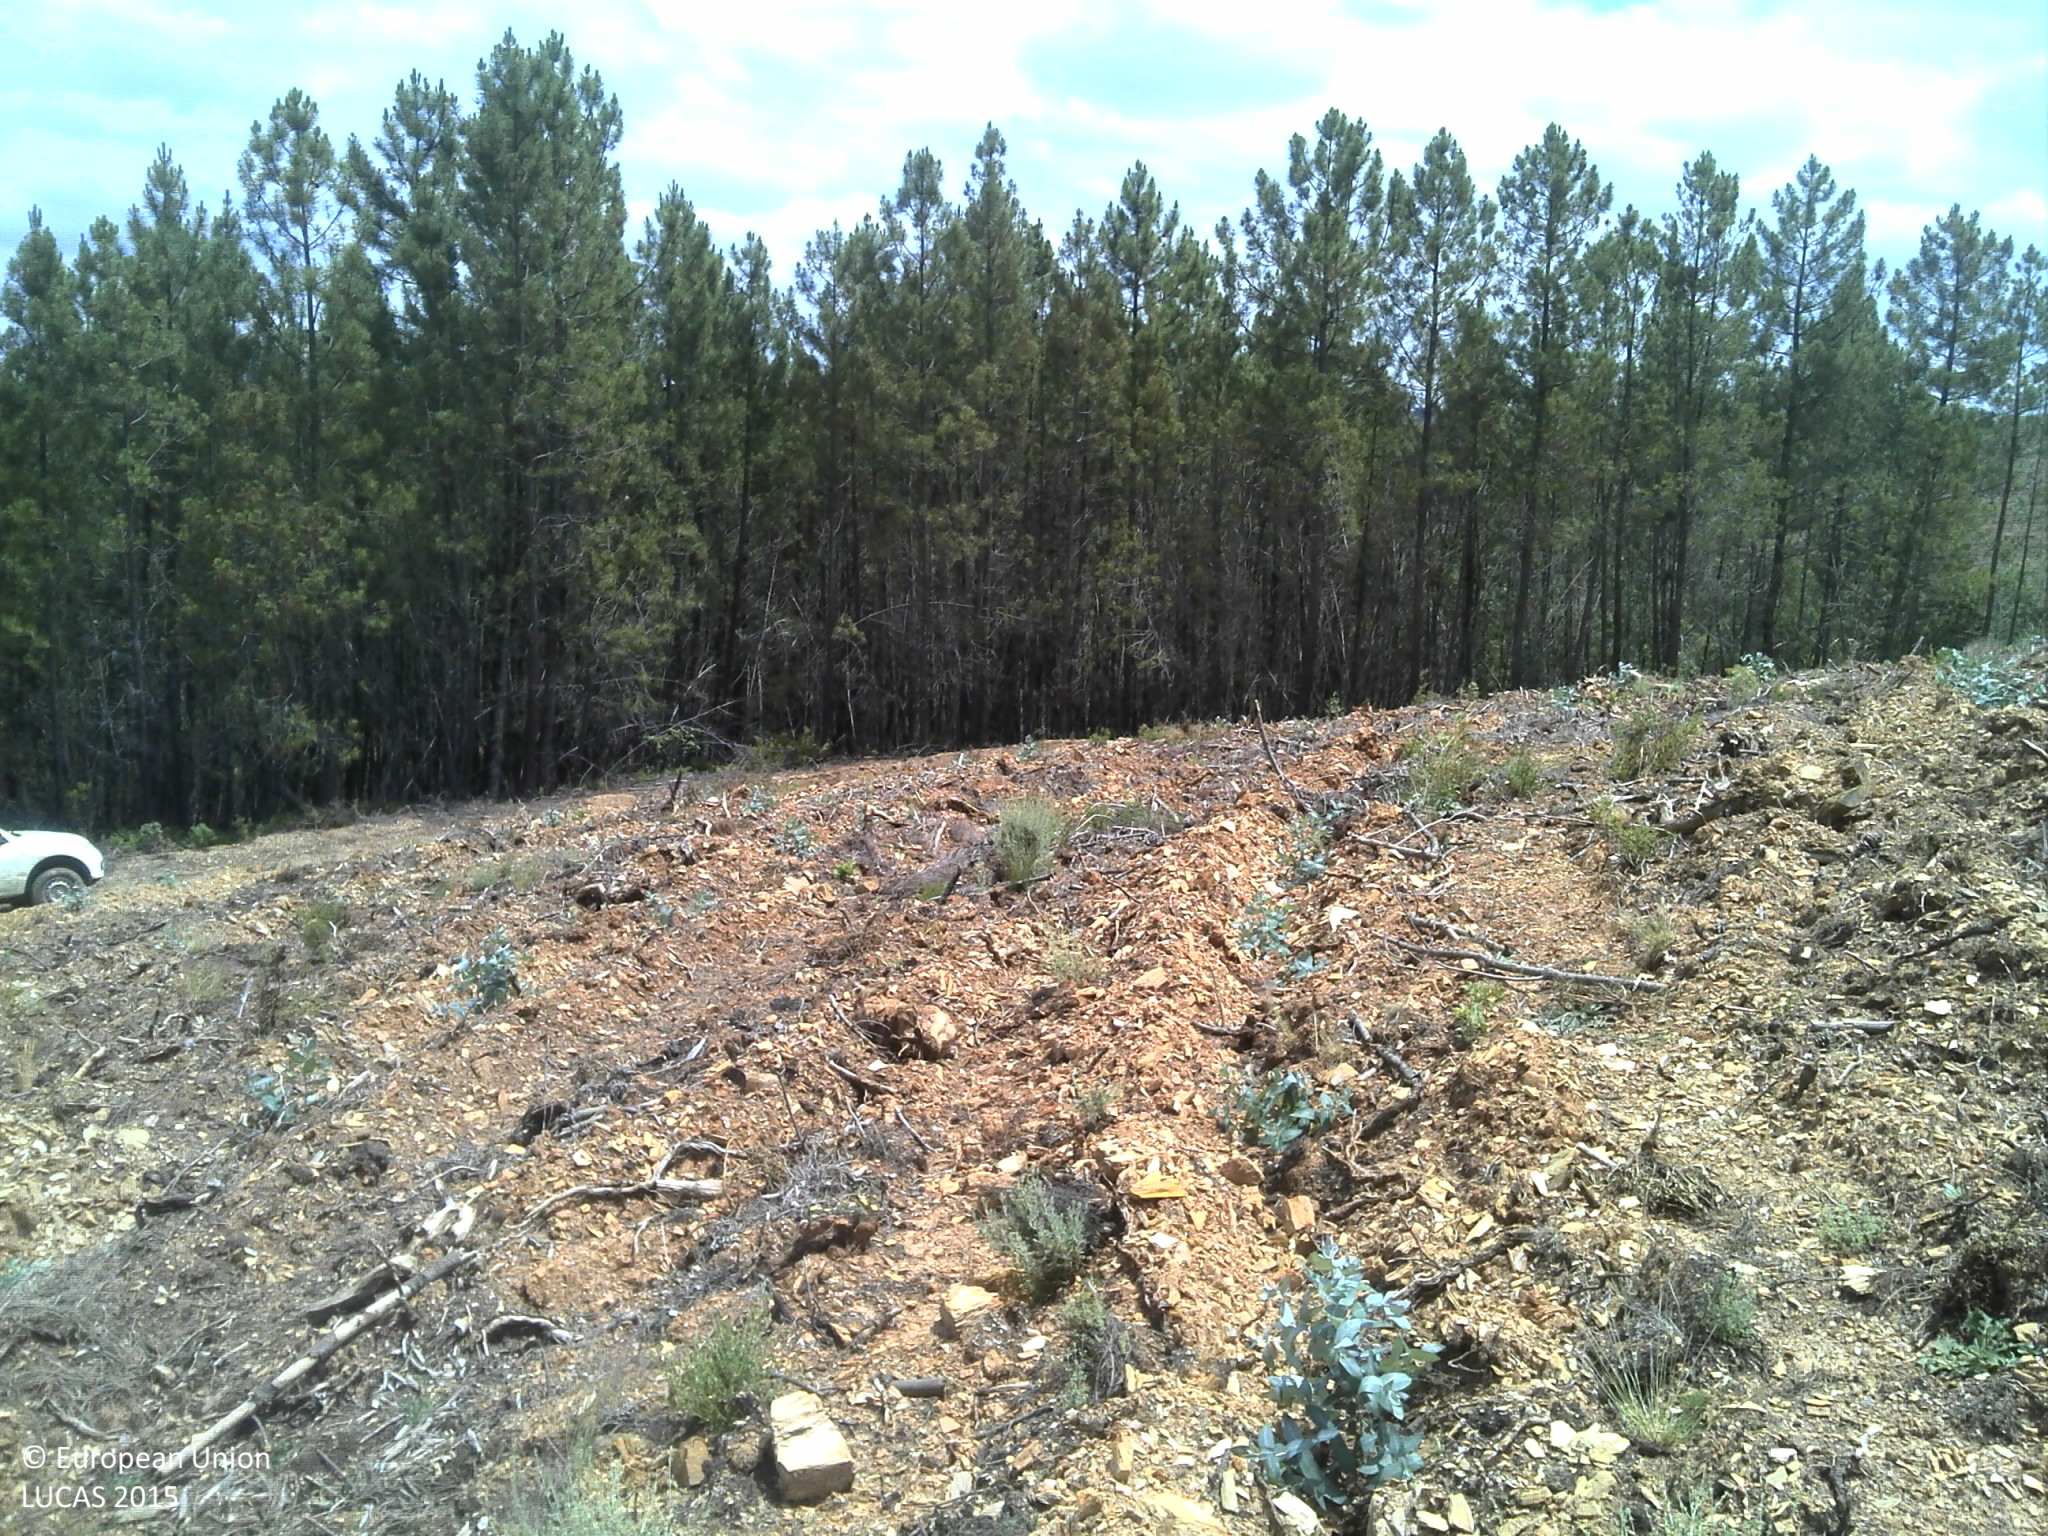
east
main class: Woodland
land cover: Broadleaved woodland
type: exotic forest
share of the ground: < 10 %
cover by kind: unconsolidated bare surface 85 %, broadleaved forest trees 10 %, herbaceous plants 5 %
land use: Forestry
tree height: < 5 m
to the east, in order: Broadleaved woodland; Tracks; Pine dominated coniferous woodland; Shrubland without tree cover; Broadleaved woodland
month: June
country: PT
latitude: 40.1617
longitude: -7.3731
